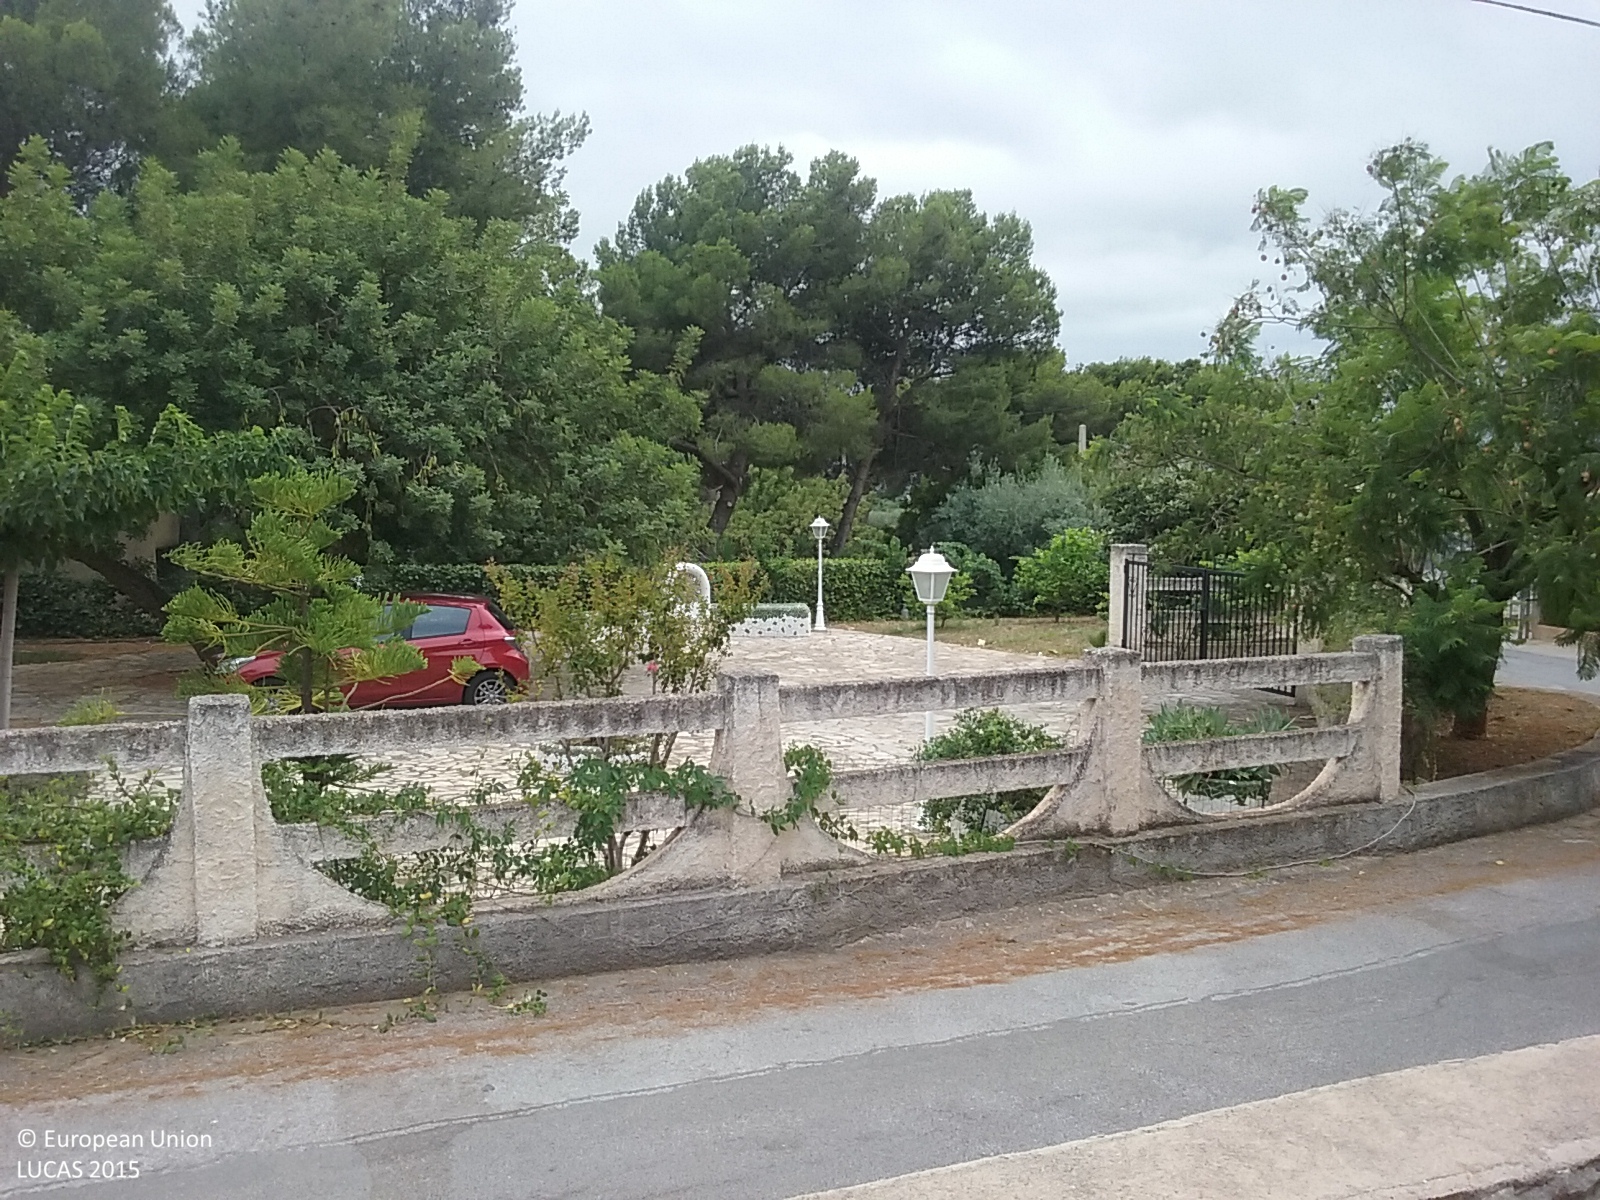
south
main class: Grassland
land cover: Grassland with sparse tree/shrub cover
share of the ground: > 75 %
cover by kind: herbaceous plants 90 %, coniferous forest trees 5 %, unconsolidated bare surface 5 %
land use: Abandoned areas
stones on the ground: > 50 %
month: July
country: ES
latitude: 40.0144
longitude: -0.1358
